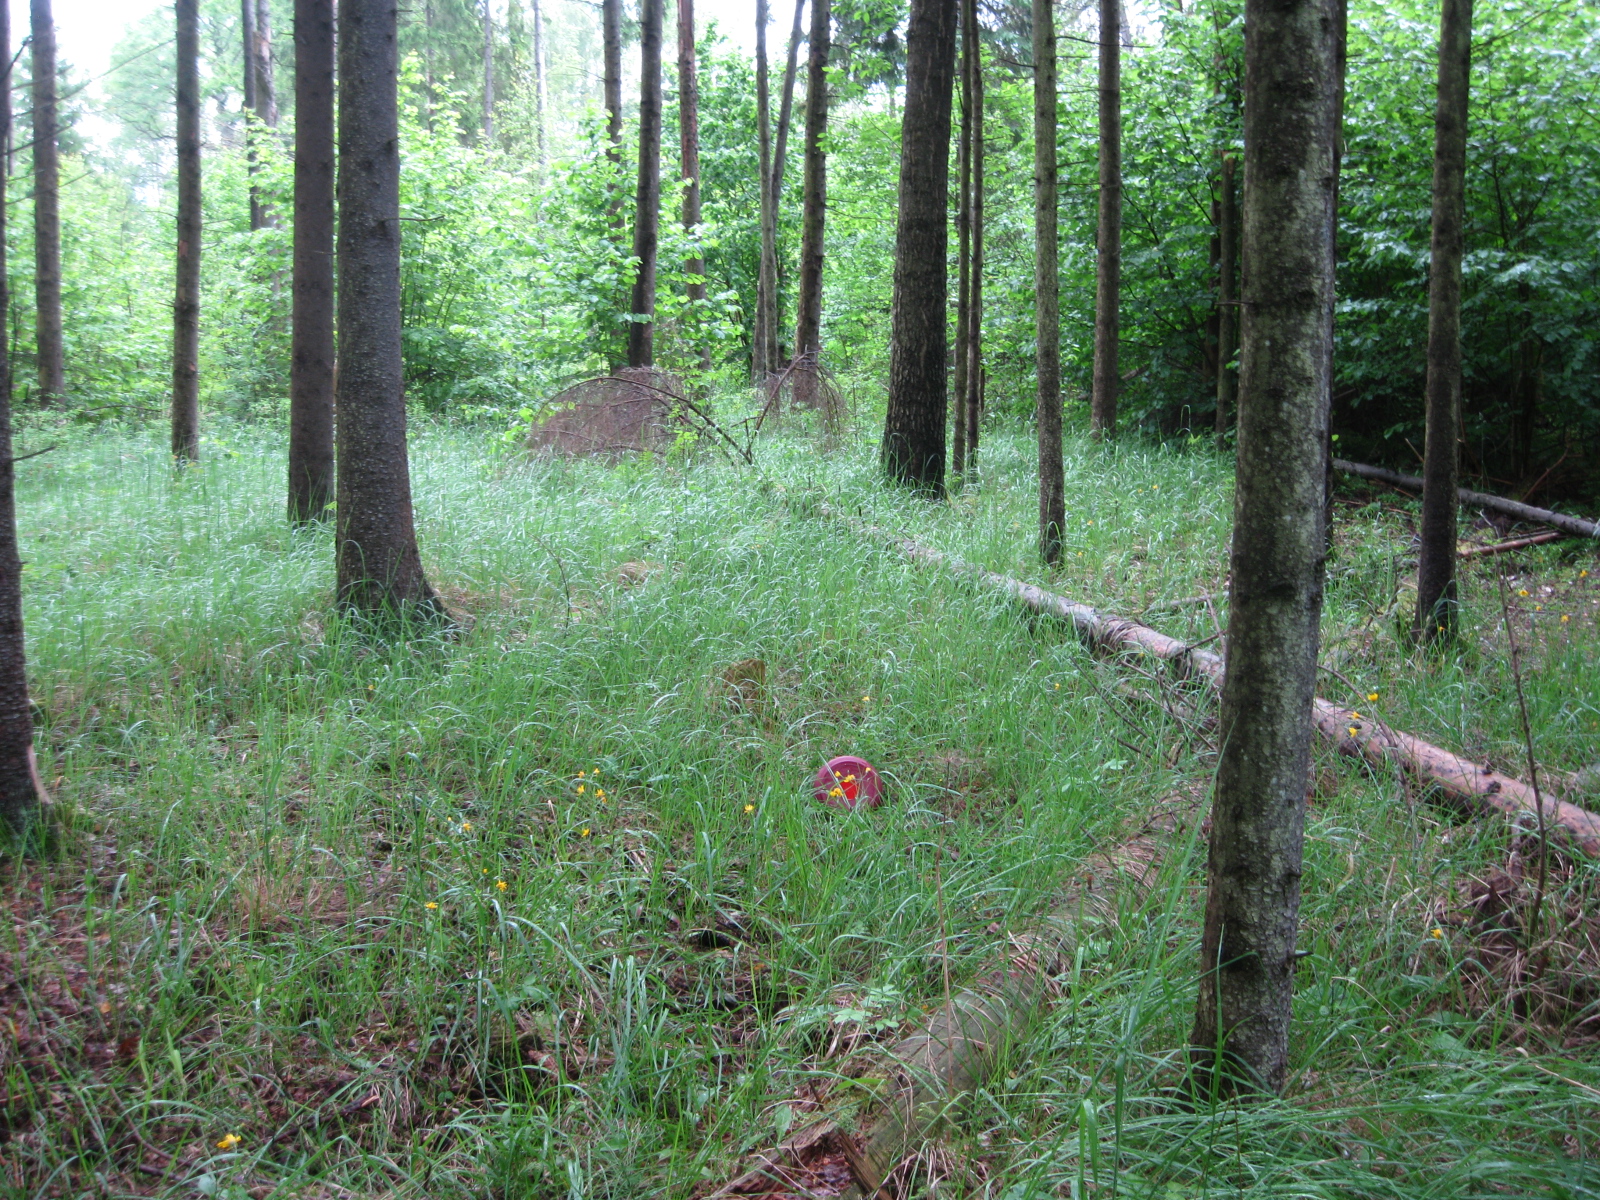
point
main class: Woodland
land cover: Spruce dominated mixed woodland
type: hemiboreal forest and nemoral coniferous forest and mixed broadleaved-coniferous forest
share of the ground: > 75 %
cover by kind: coniferous forest trees 50 %, broadleaved forest trees 30 %, herbaceous plants 20 %
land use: Forestry
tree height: > 5 m
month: June
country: LT
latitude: 55.4033
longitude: 23.7765
